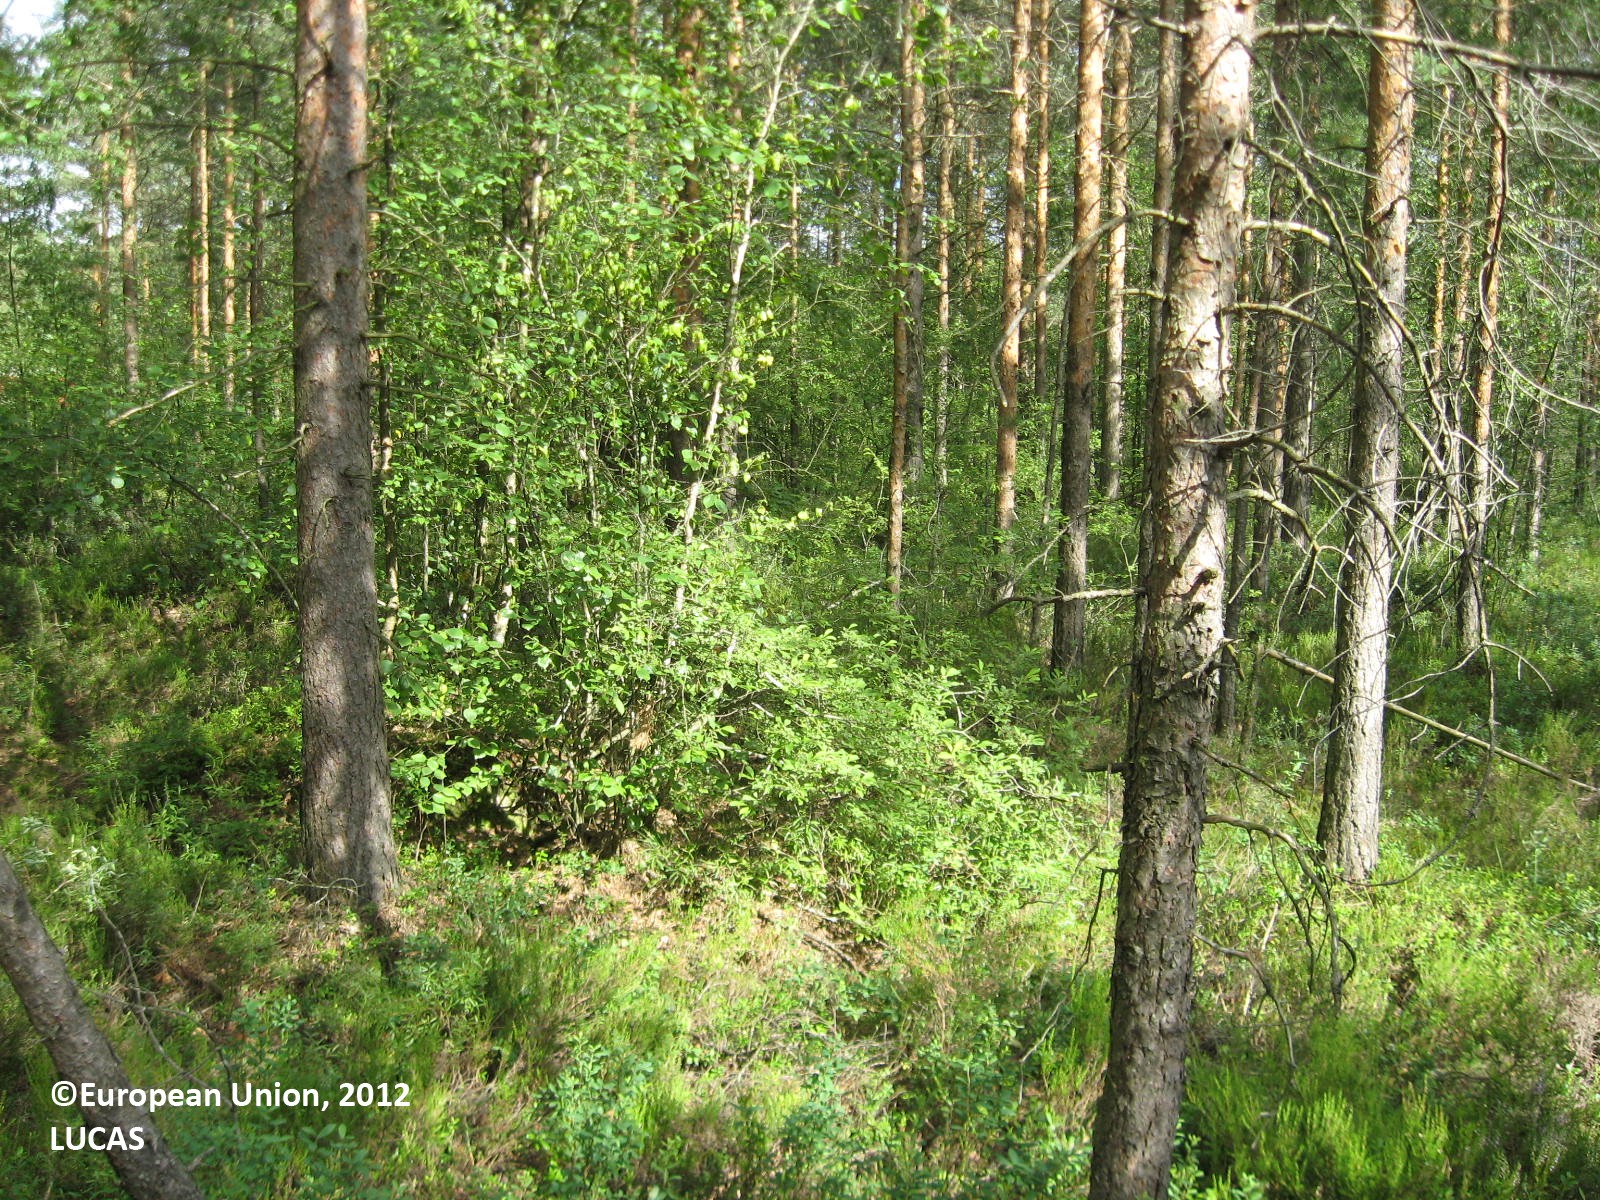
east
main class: Woodland
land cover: Pine dominated coniferous woodland
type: boreal forest
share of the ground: > 75 %
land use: Forestry
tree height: > 5 m
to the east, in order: Pine dominated coniferous woodland; Ditches and canals; Pine dominated coniferous woodland; Ditches and canals; Pine dominated coniferous woodland; Ditches and canals; Pine dominated coniferous woodland; Ditches and canals; Pine dominated coniferous woodland; Grassland without tree/shrub cover; Electric lines; Grassland without tree/shrub cover; Pine dominated coniferous woodland; Electric lines; Broadleaved woodland
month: July
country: FI
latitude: 61.9789
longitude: 22.2876
